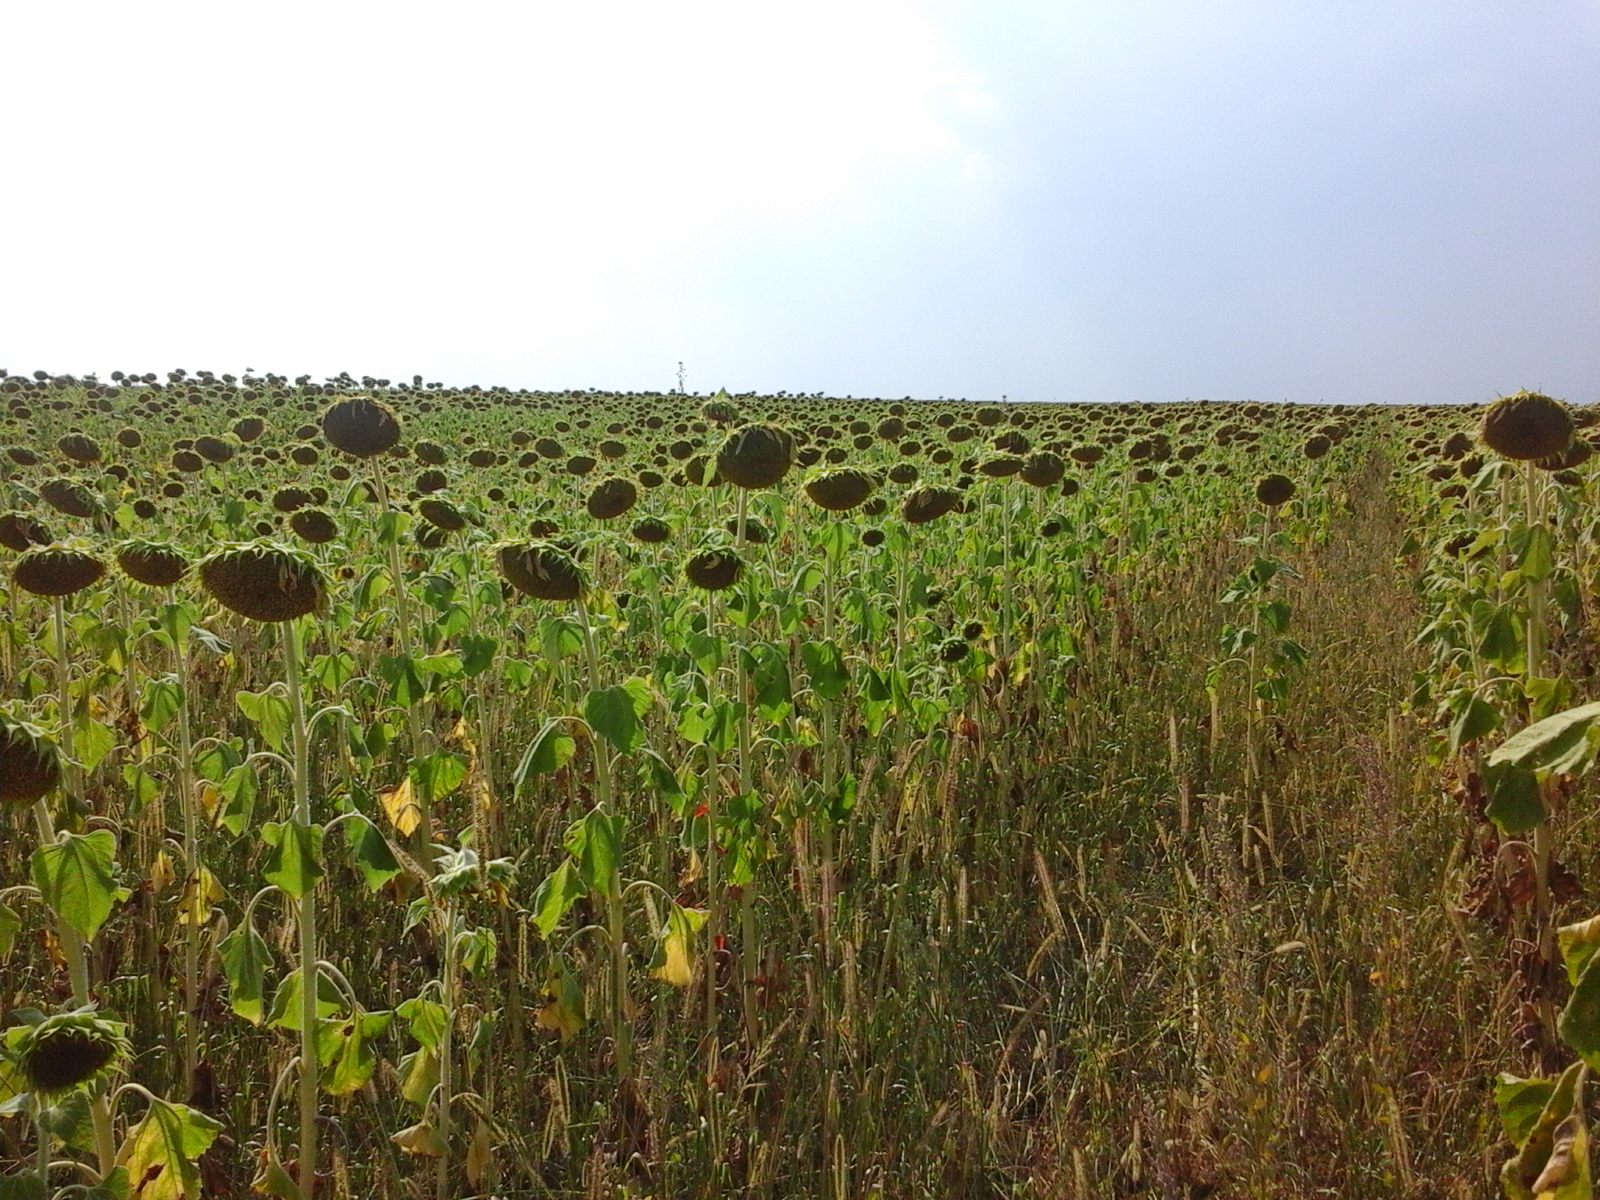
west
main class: Cropland
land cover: Sunflower
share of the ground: > 75 %
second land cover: Spontaneously vegetated surfaces
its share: 50 - 75 %
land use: Fallow land
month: August
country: RO
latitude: 44.1957
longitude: 23.6285
